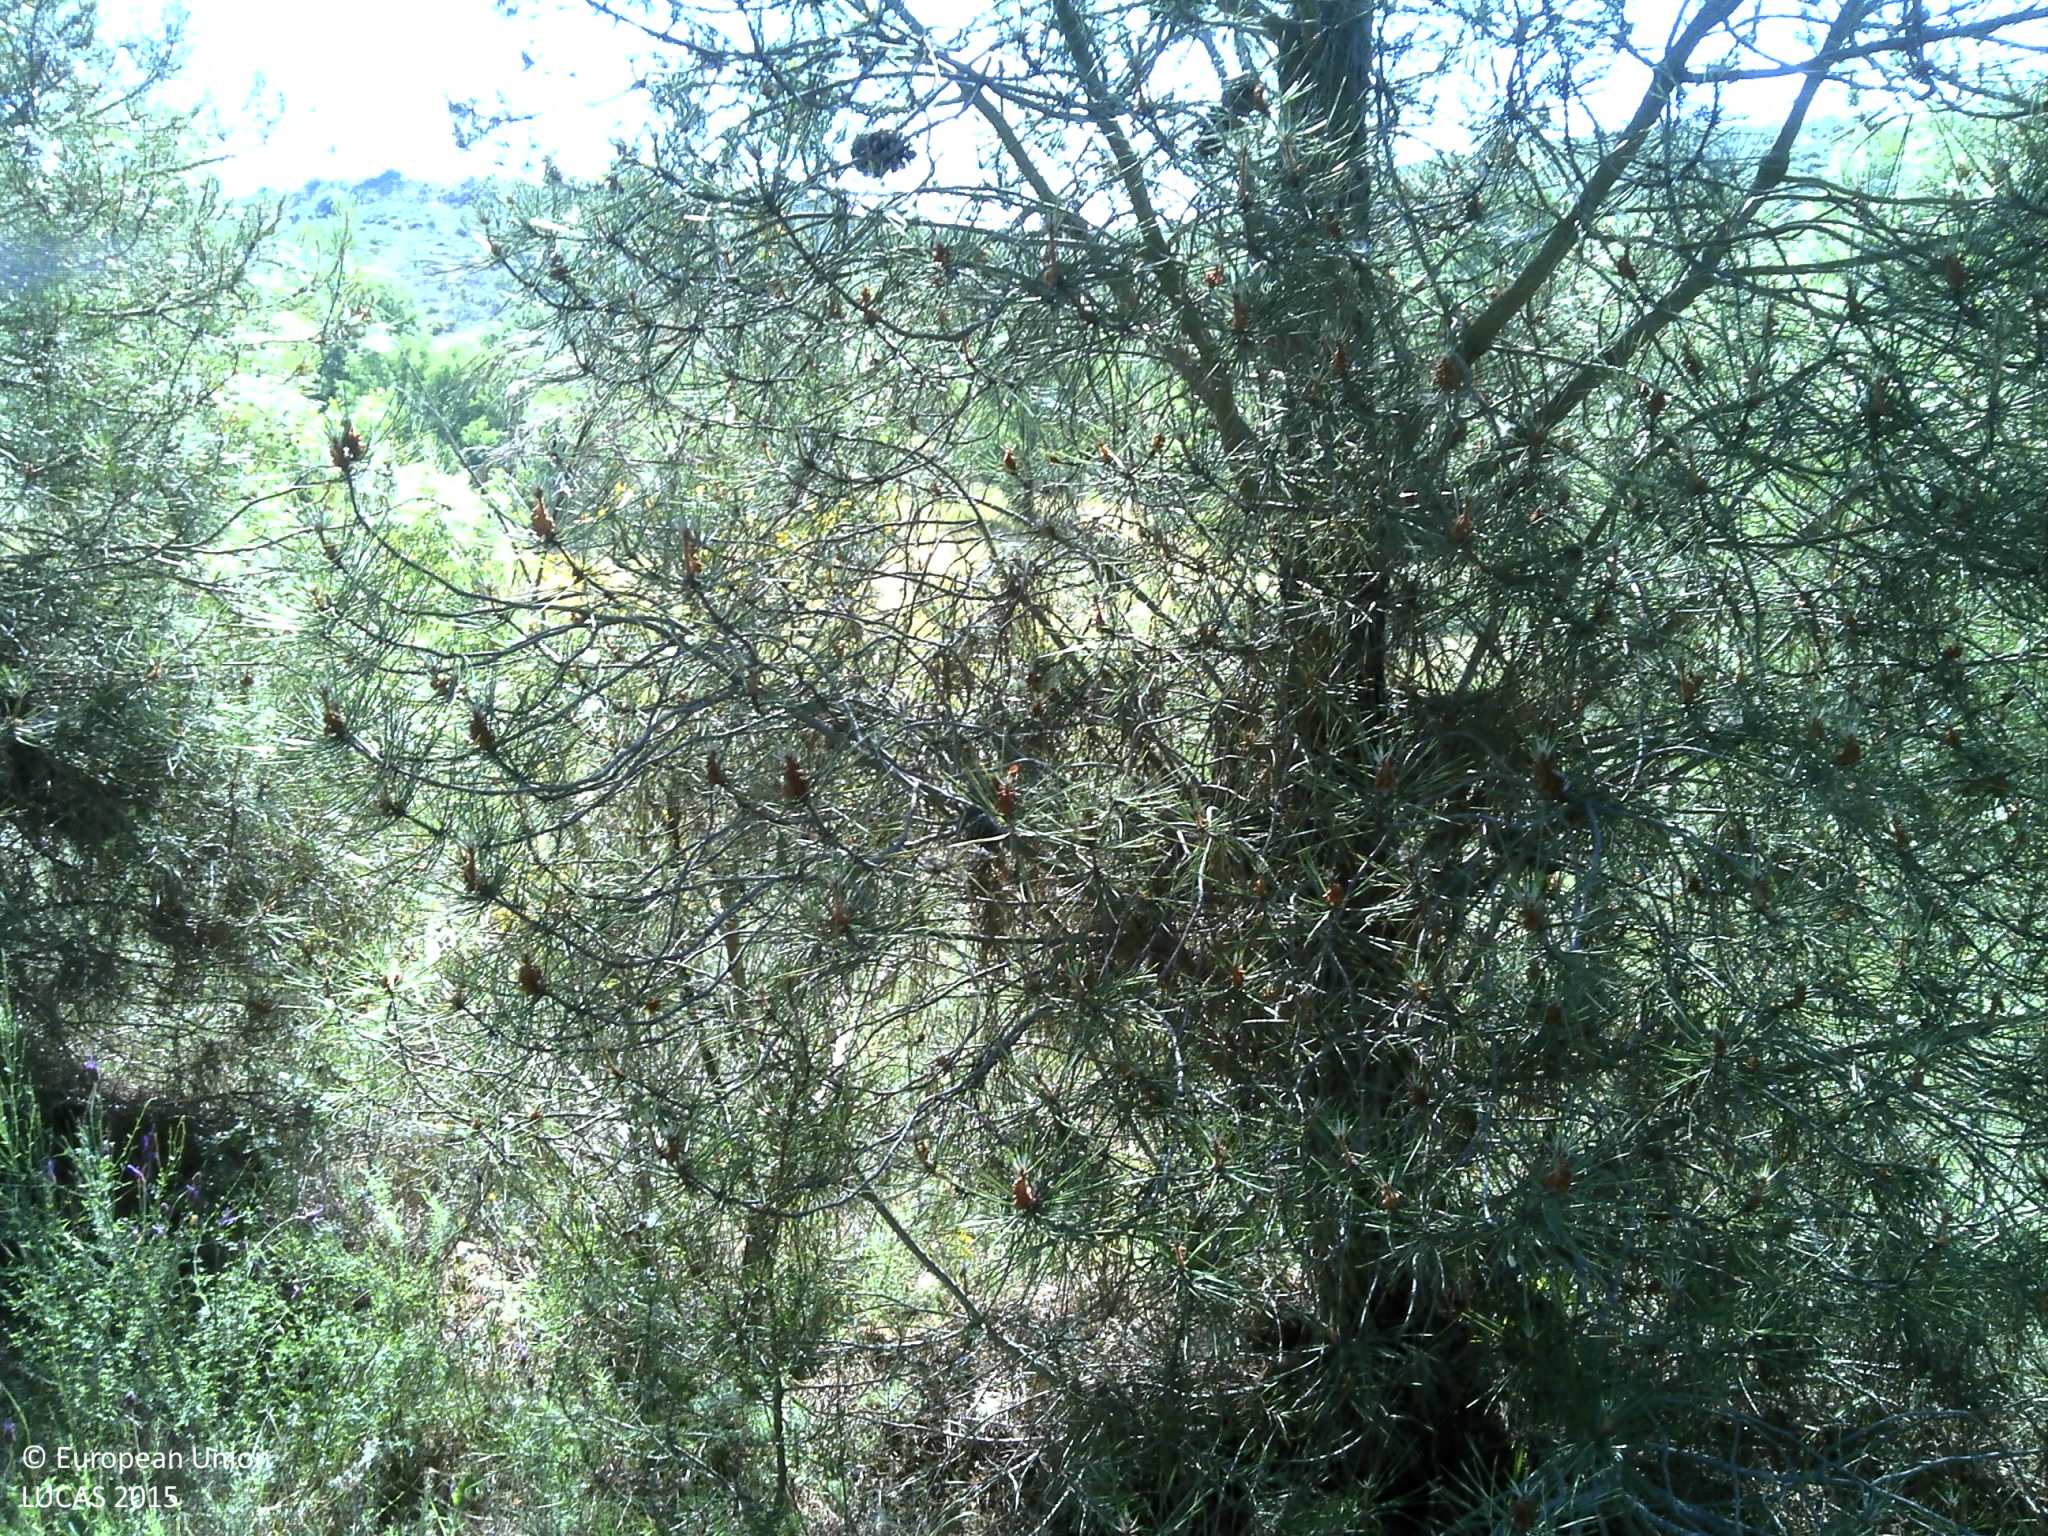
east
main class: Woodland
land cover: Pine dominated coniferous woodland
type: coniferous forest of the mediterranean region
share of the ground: 10 - 25 %
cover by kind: coniferous forest trees 20 %, shrubs 20 %, herbaceous plants 10 %, unconsolidated bare surface 10 %
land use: Forestry
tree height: > 5 m
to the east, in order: Pine dominated coniferous woodland; Tracks; Grass margins; Dry stone walls; Shruby margins; Grassland without tree/shrub cover; Single bushes/trees; Grassland without tree/shrub cover; Rivers and streams; Grassland without tree/shrub cover; Broadleaved woodland; Lines of trees; Dry stone walls; Shruby margins; Grass margins; Tracks; Grass margins; Shrubland without tree cover; Shrubland with sparse tree cover; Pine dominated coniferous woodland; Broadleaved woodland; Pine dominated coniferous woodland; Shrubland with sparse tree cover
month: May
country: PT
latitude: 41.5585
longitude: -6.5432
